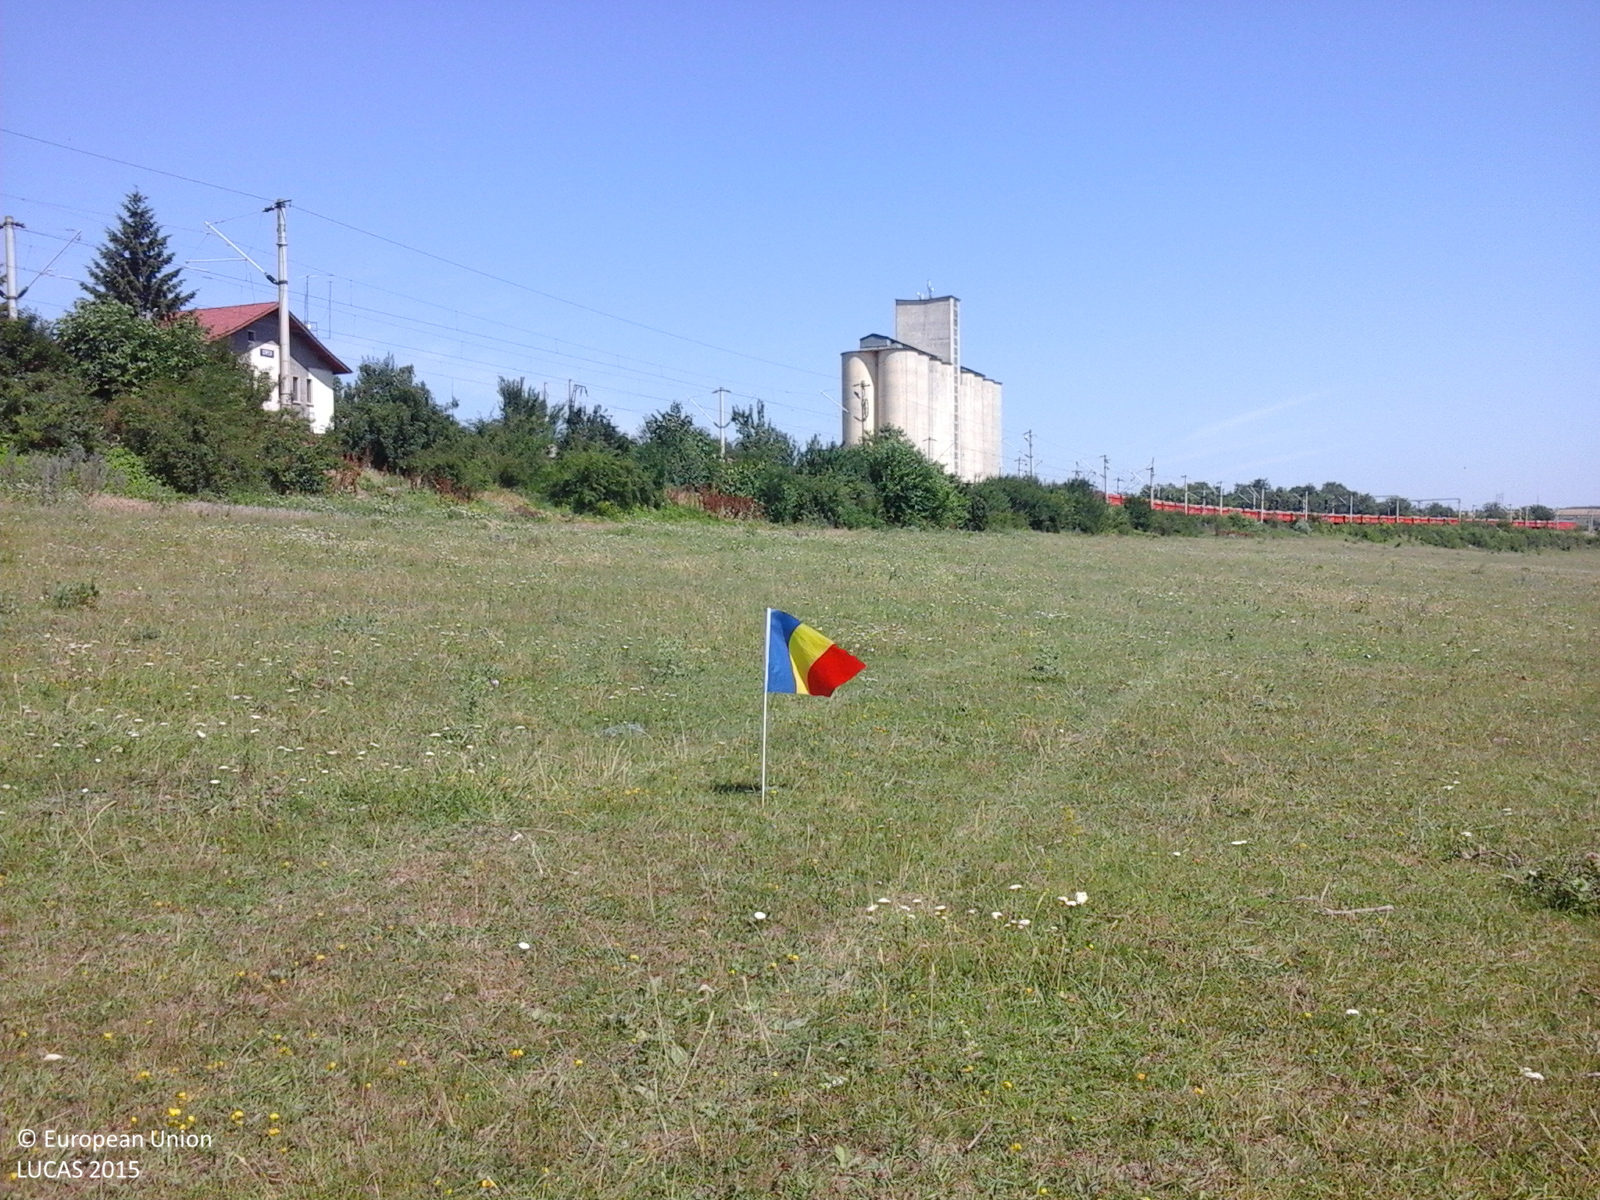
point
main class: Grassland
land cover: Grassland without tree/shrub cover
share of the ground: > 75 %
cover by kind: herbaceous plants 100 %
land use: Agriculture (excluding fallow land and kitchen gardens)
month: June
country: RO
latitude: 47.2152
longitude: 27.1522
